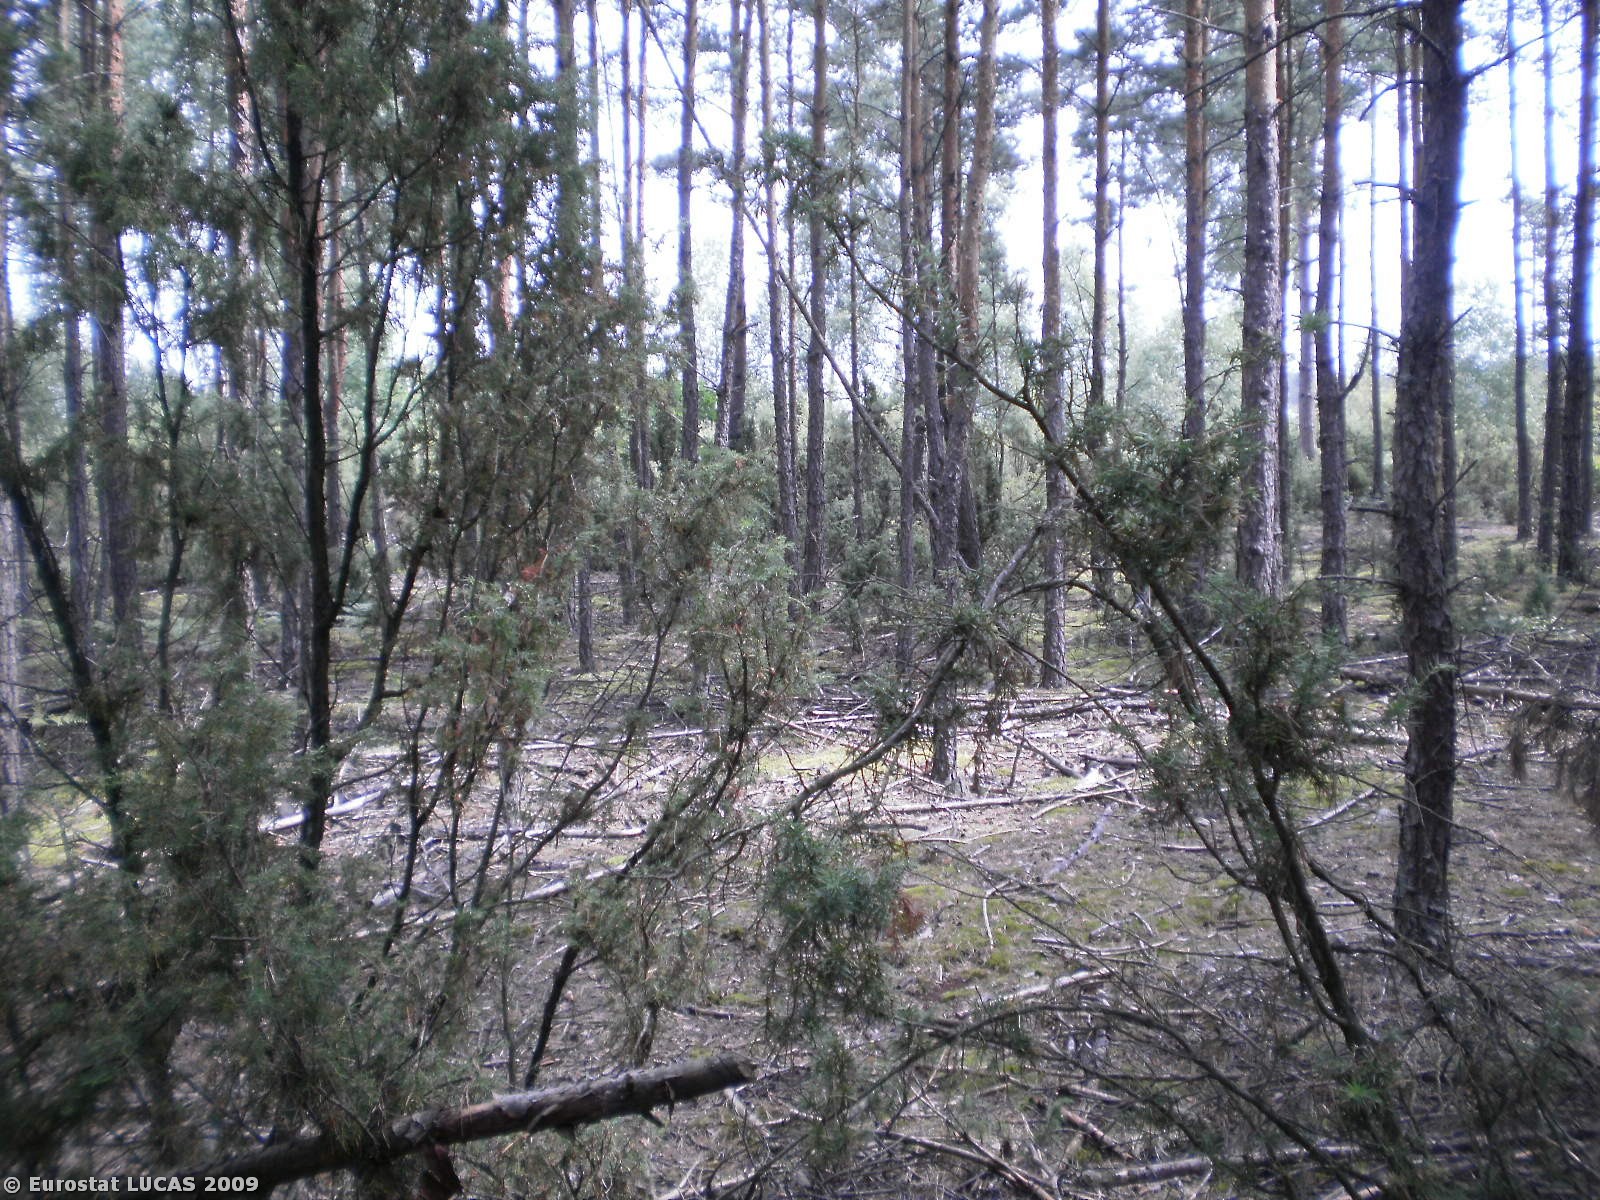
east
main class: Woodland
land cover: Coniferous woodland
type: hemiboreal forest and nemoral coniferous forest and mixed broadleaved-coniferous forest
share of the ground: > 75 %
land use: Forestry
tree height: > 5 m
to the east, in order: Coniferous woodland; Grassland without tree/shrub cover; Bare land
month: August
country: PL
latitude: 52.9182
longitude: 21.1858
